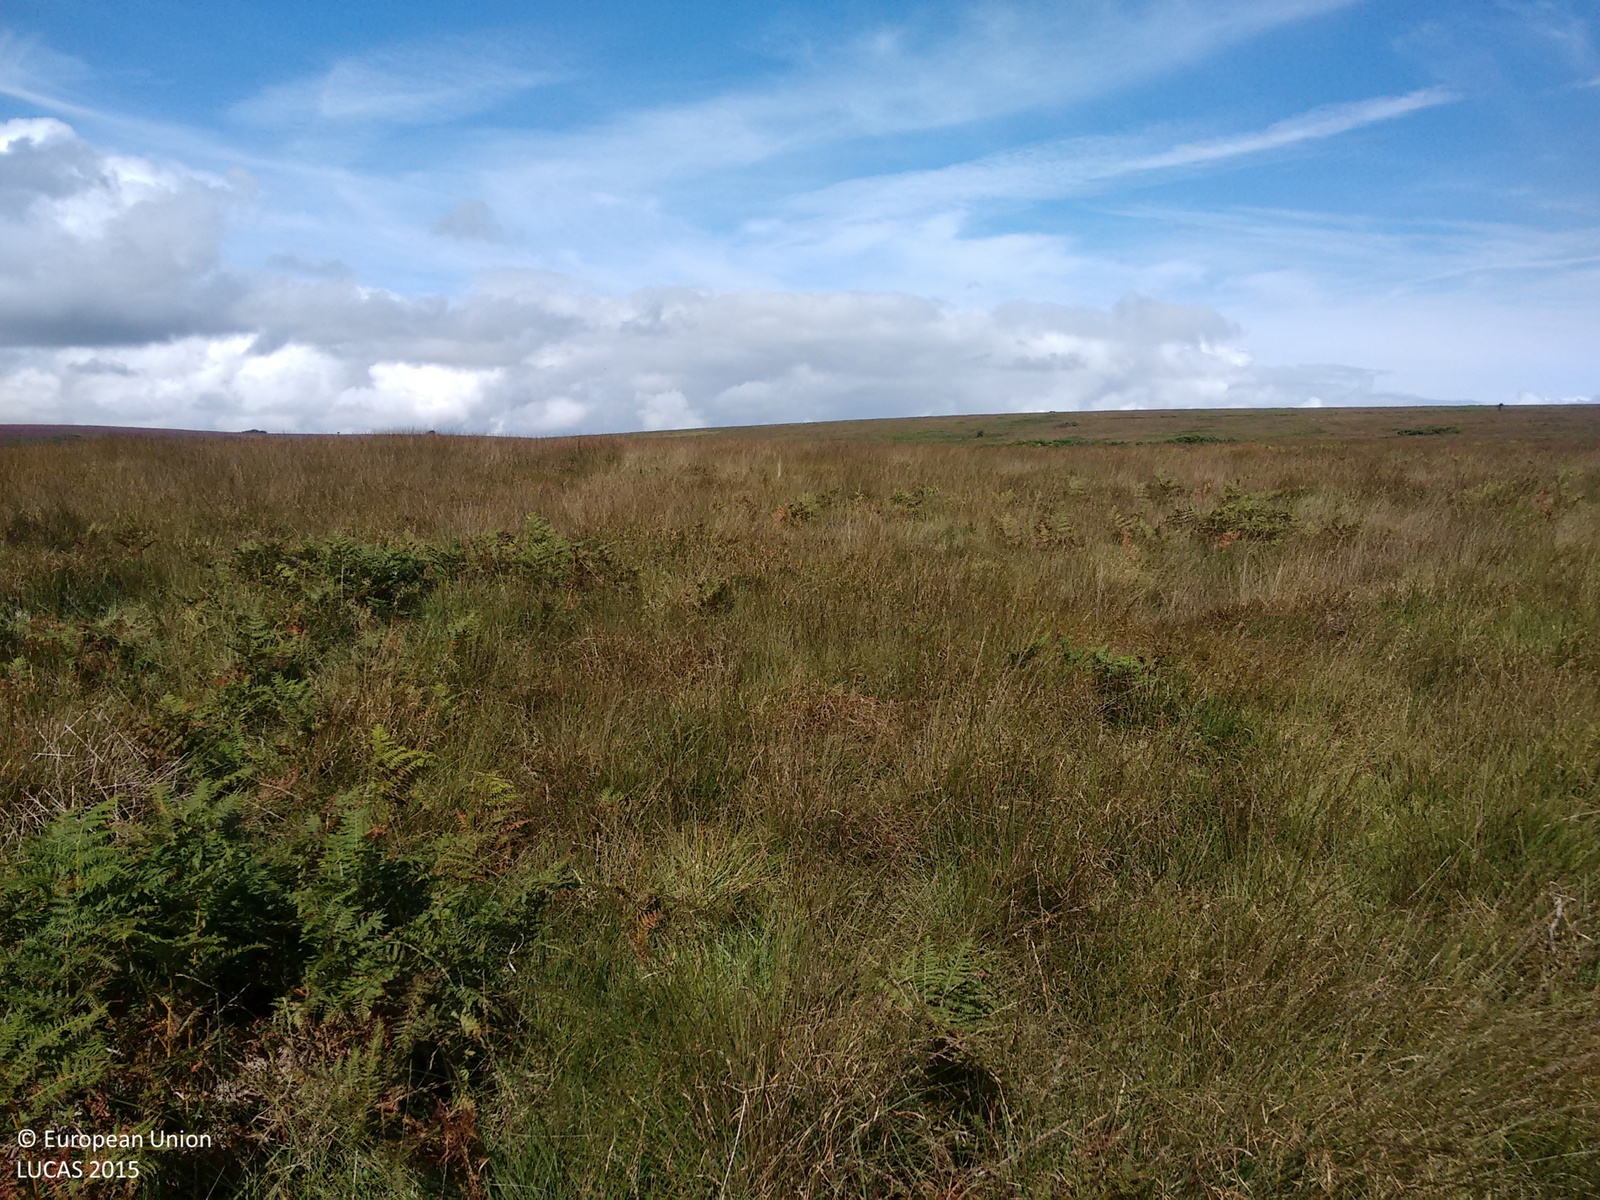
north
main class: Grassland
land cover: Grassland without tree/shrub cover
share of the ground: > 75 %
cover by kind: herbaceous plants 95 %, shrubs 5 %
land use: Agriculture (excluding fallow land and kitchen gardens)
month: September
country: GB
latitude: 51.0511
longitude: -3.6828
